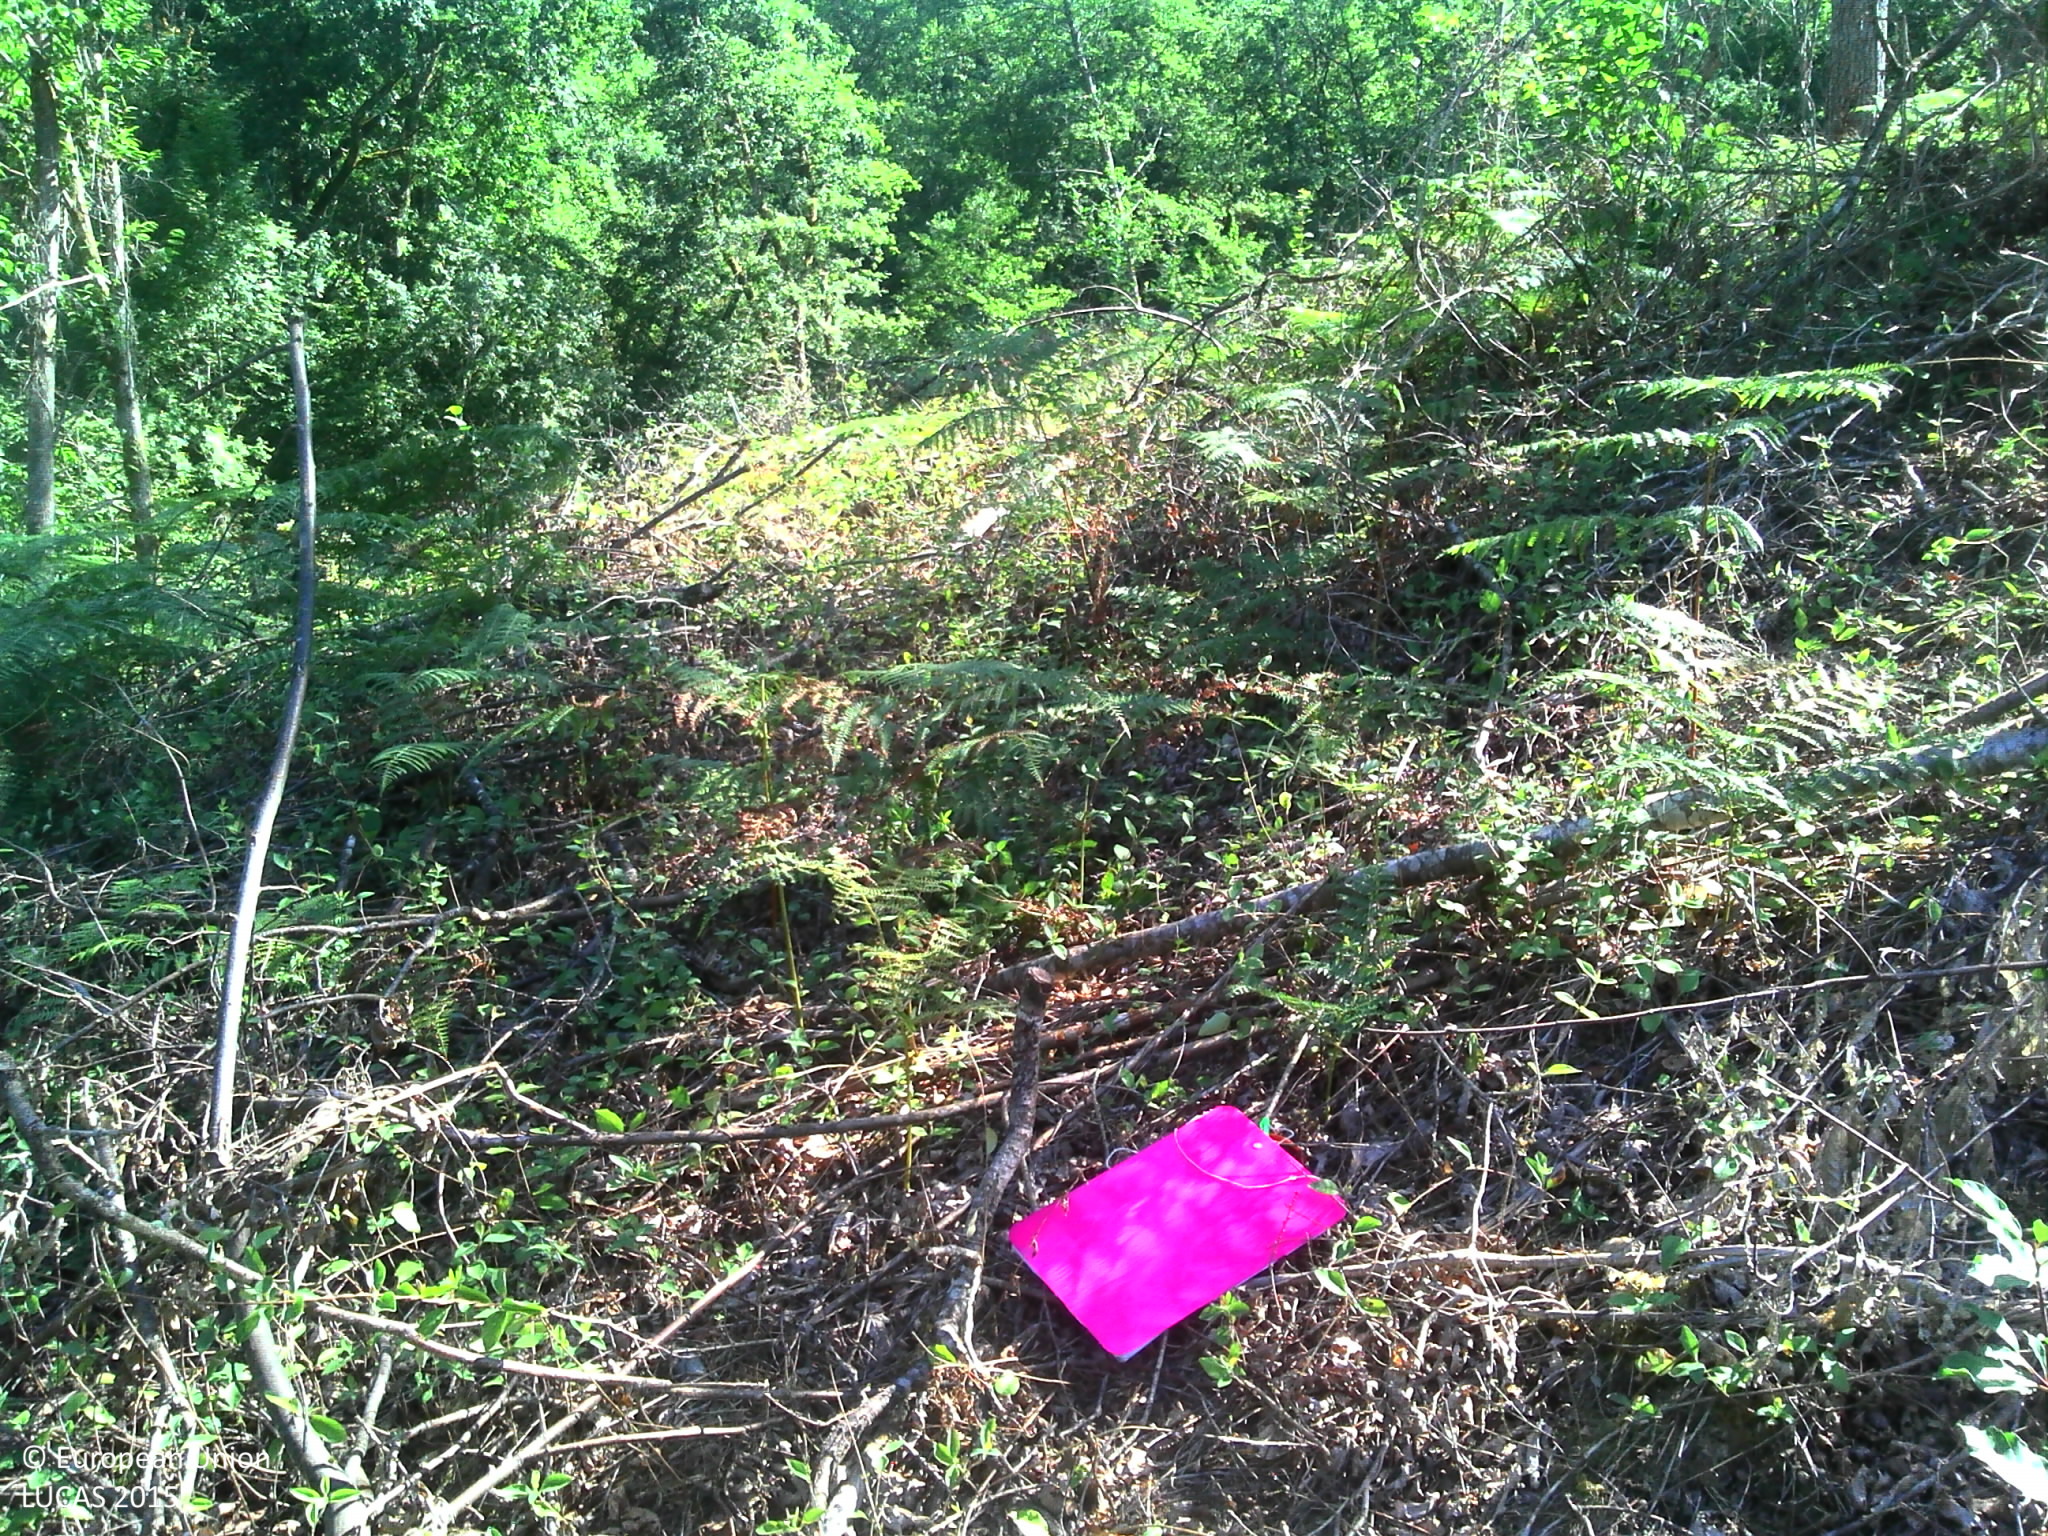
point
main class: Grassland
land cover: Spontaneously vegetated surfaces
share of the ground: > 75 %
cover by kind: herbaceous plants 95 %, shrubs 5 %
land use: Forestry
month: August
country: FR
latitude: 45.8795
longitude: 1.4234
